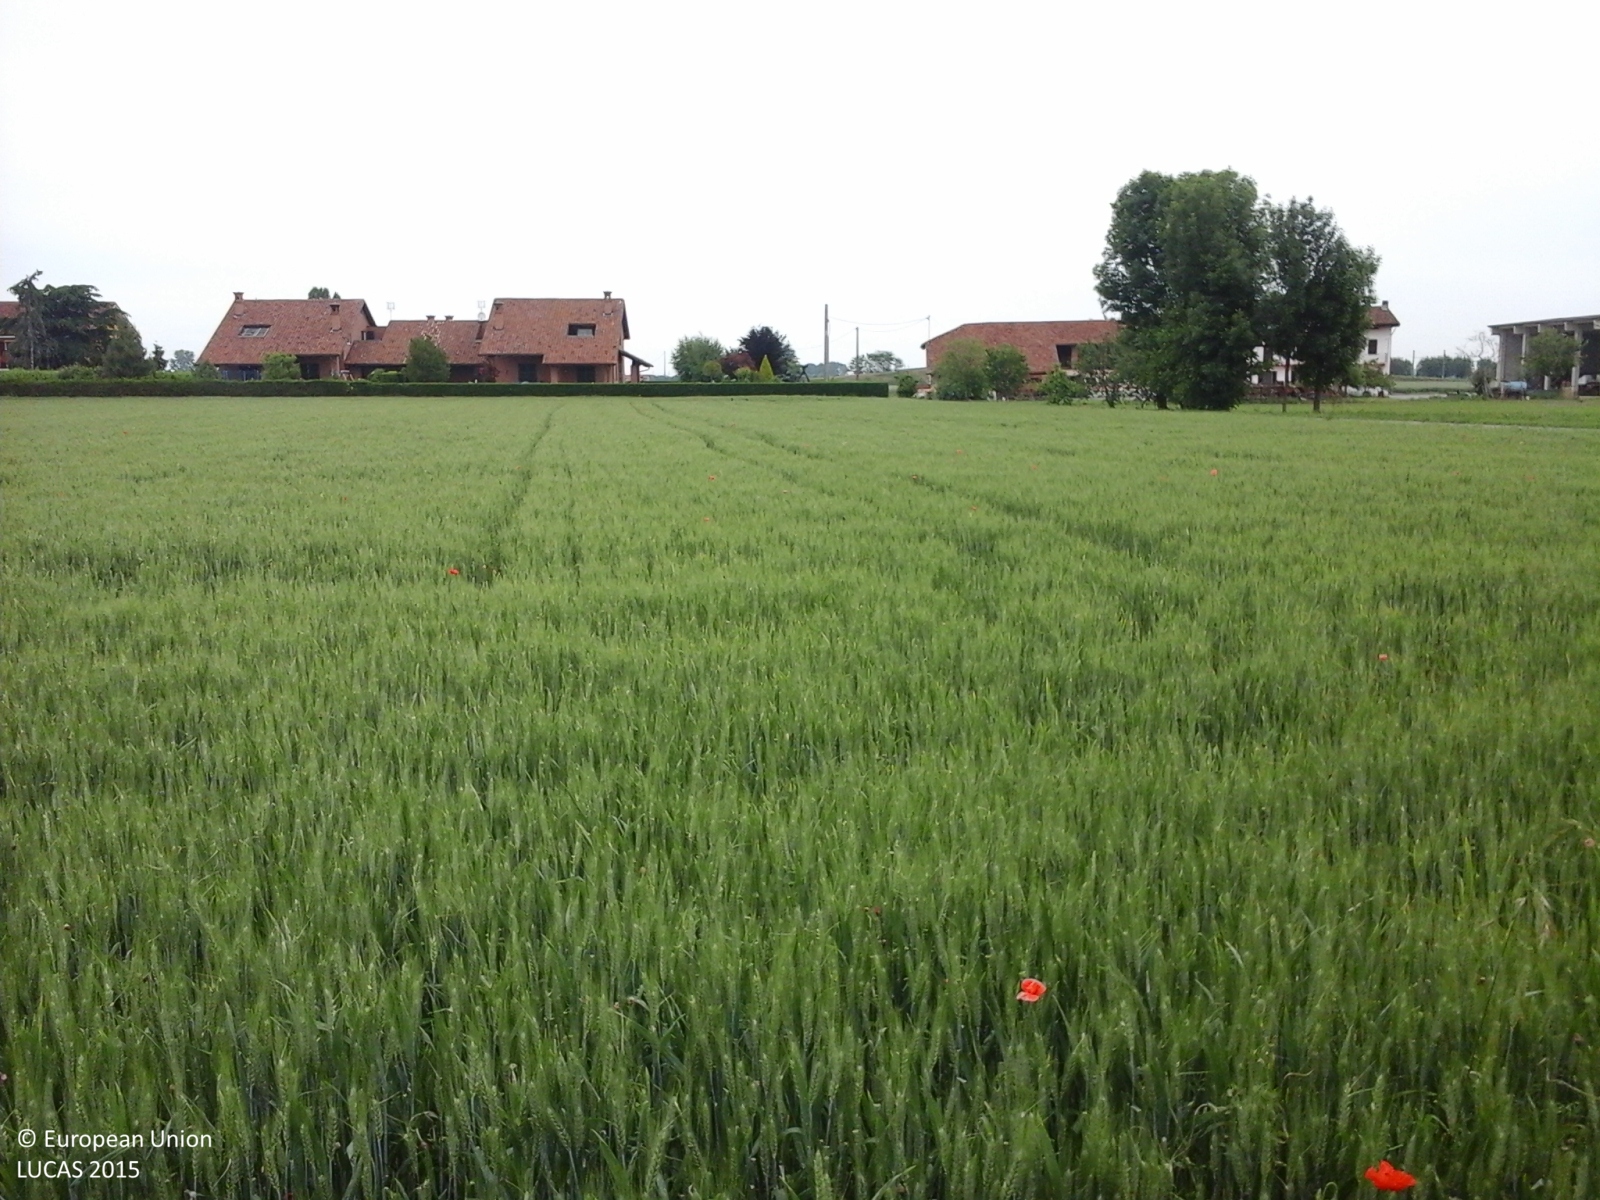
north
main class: Cropland
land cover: Common wheat
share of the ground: > 75 %
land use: Agriculture (excluding fallow land and kitchen gardens)
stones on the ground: < 10 %
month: May
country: IT
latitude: 44.5777
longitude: 7.7000
